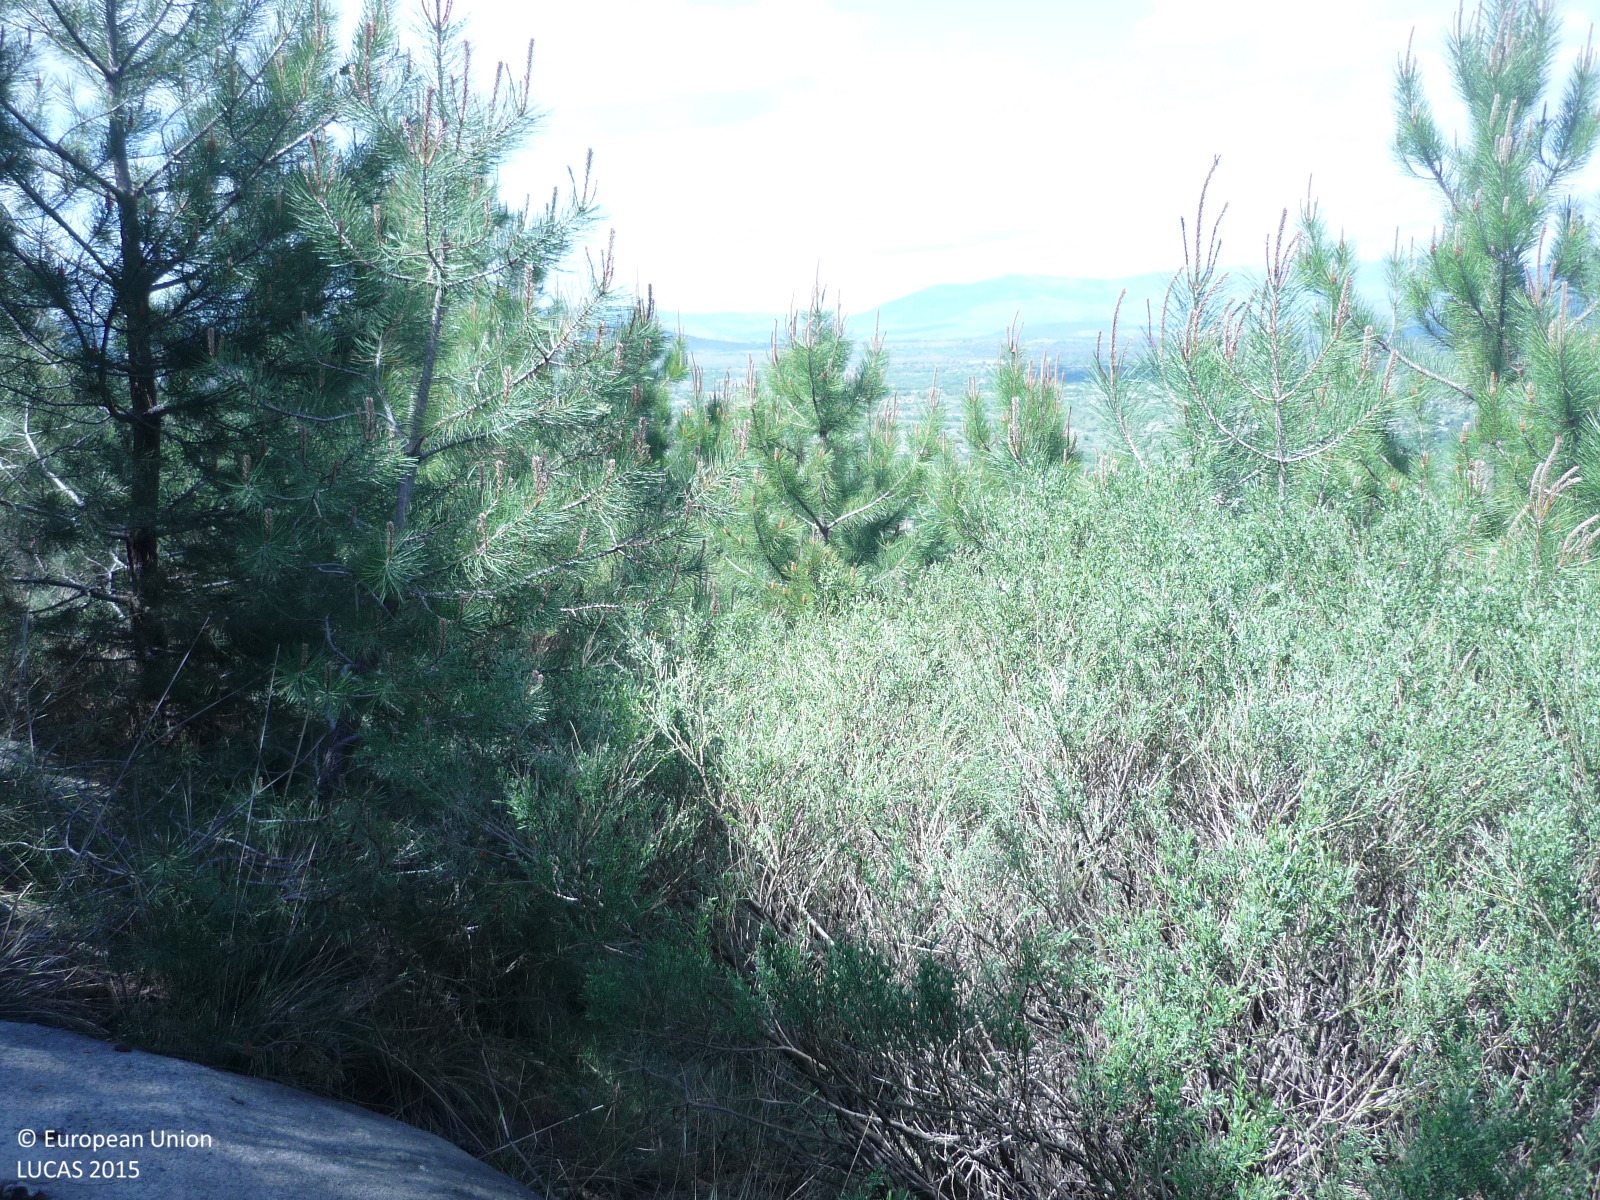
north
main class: Woodland
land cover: Pine dominated coniferous woodland
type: coniferous forest of the mediterranean region
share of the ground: 50 - 75 %
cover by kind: coniferous forest trees 70 %, shrubs 20 %, herbaceous plants 10 %
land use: Semi-natural and natural areas not in use
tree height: < 5 m
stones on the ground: 10 - 25 %
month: May
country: ES
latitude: 40.8892
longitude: -3.6081
